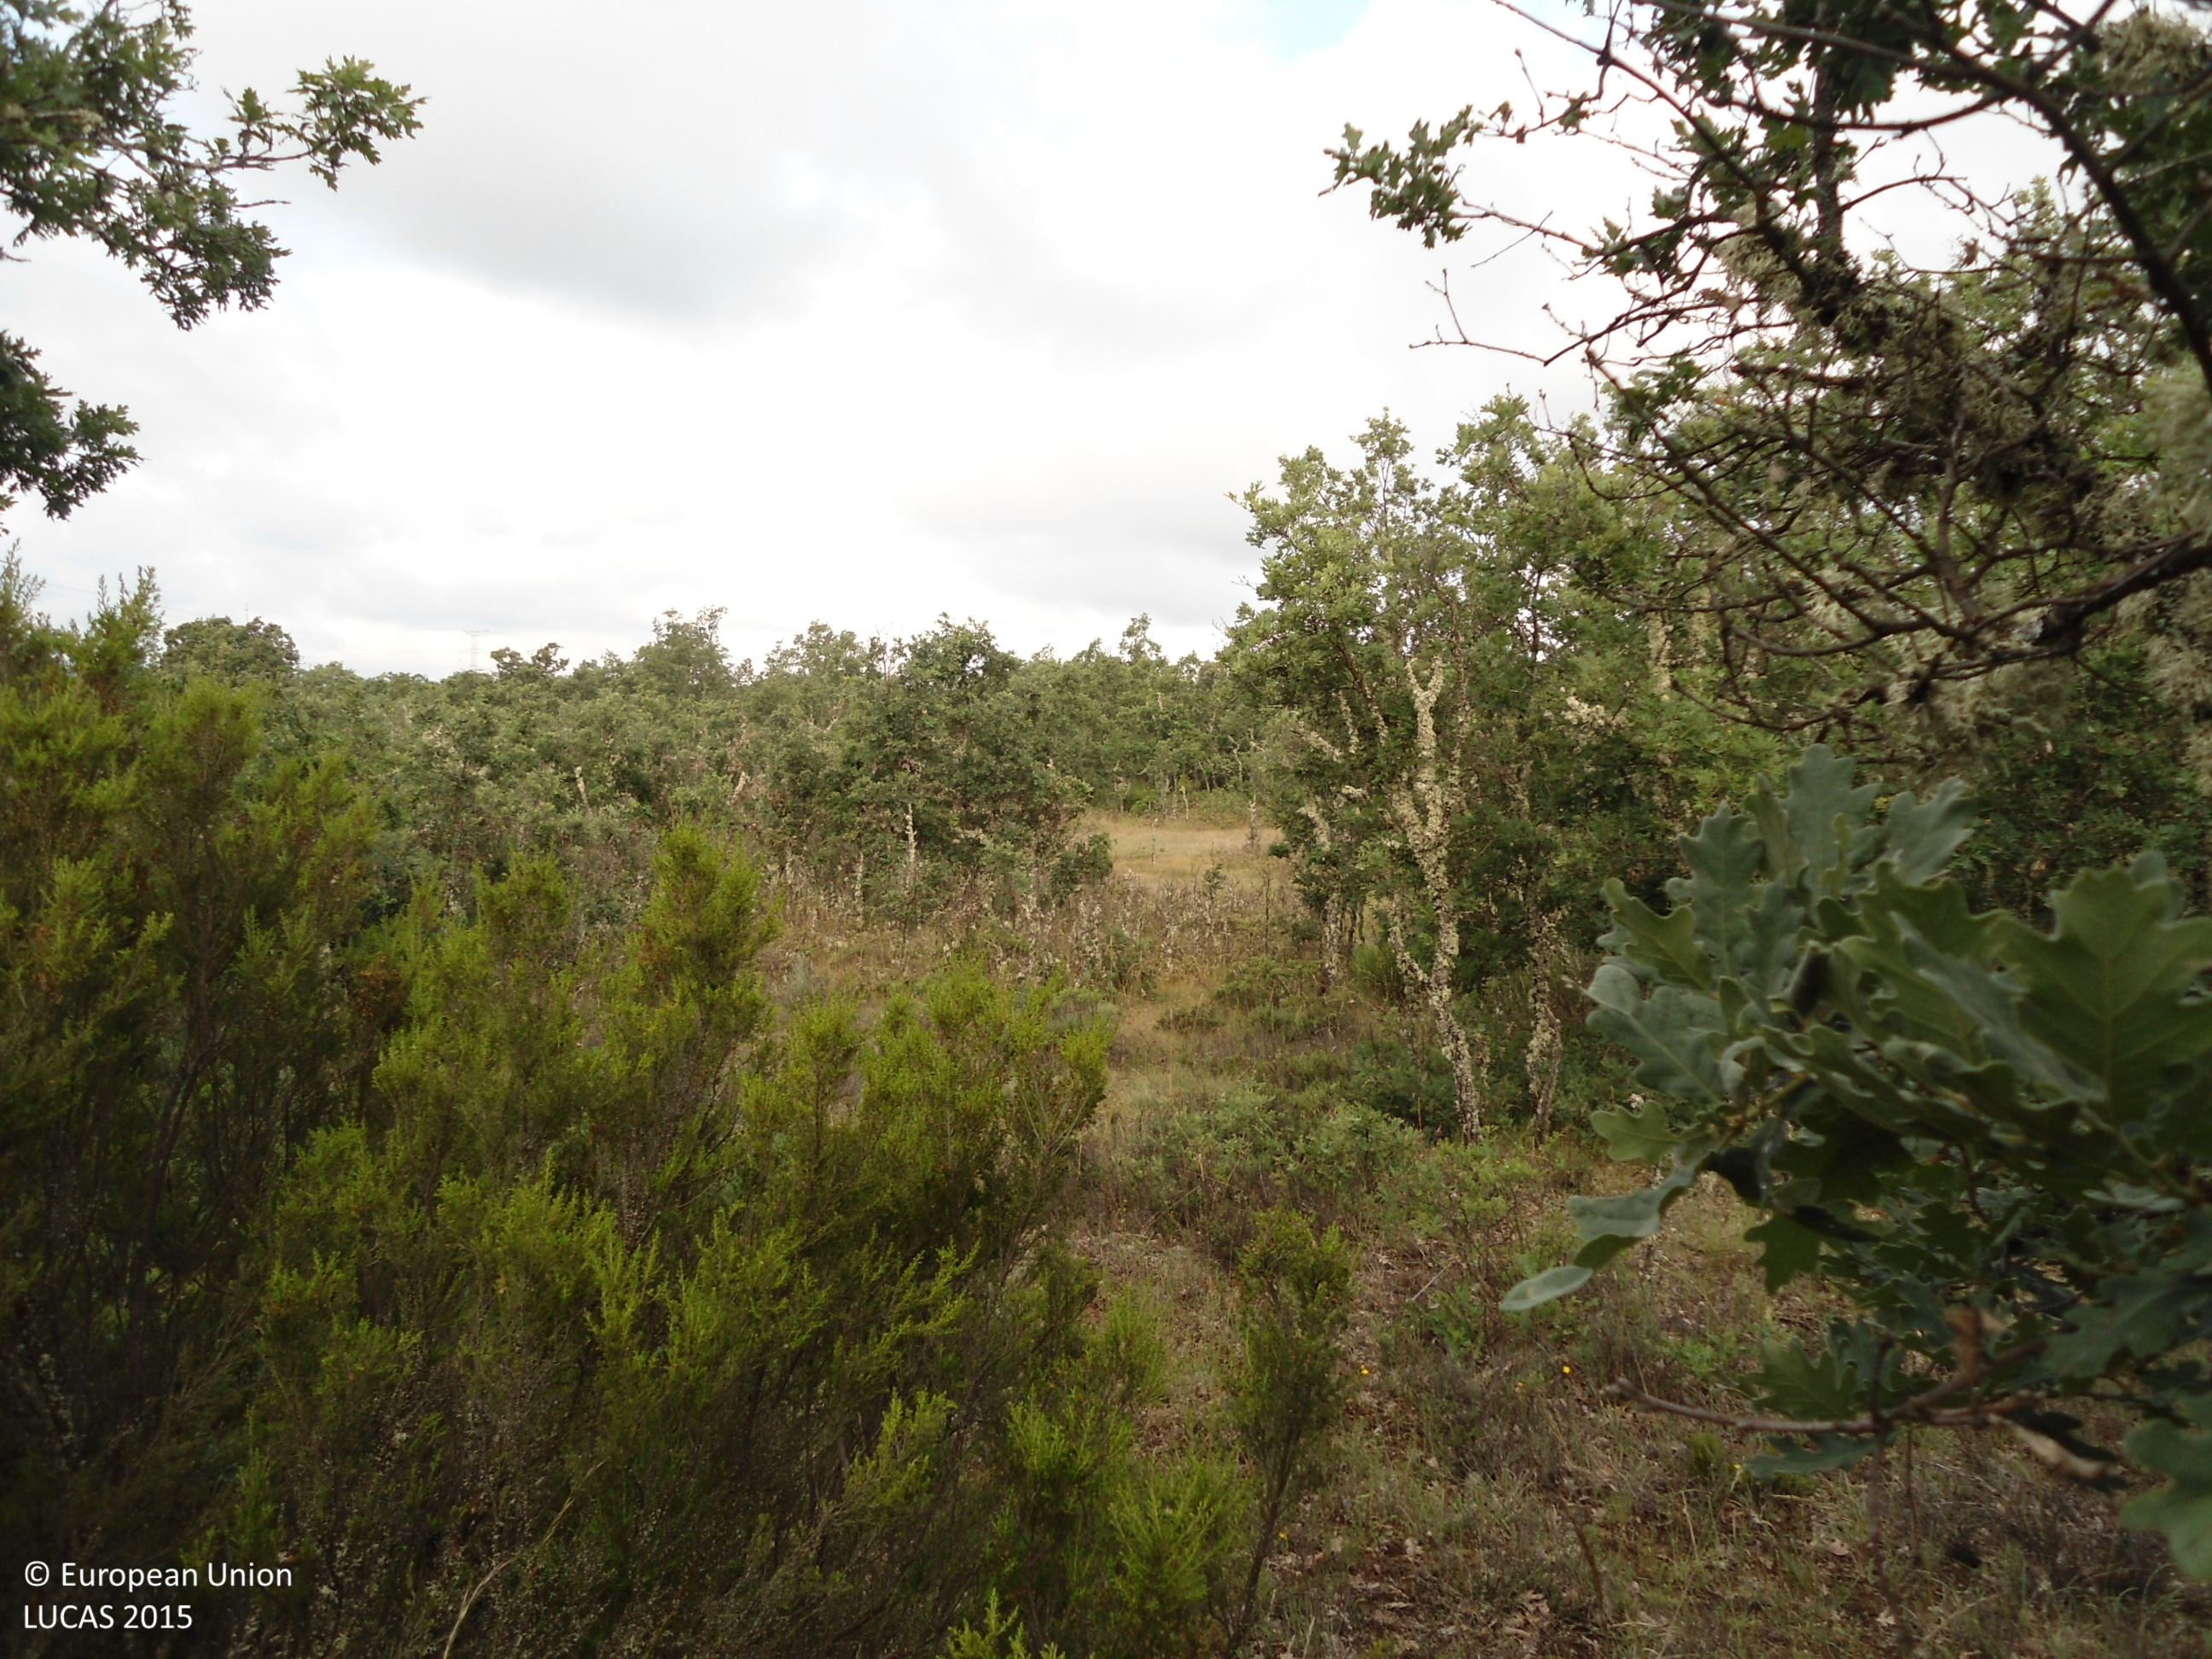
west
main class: Woodland
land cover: Broadleaved woodland
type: broadleaved evergreen forest
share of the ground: > 75 %
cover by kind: broadleaved forest trees 90 %, shrubs 10 %
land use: Forestry
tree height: > 5 m
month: June
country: ES
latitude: 42.0277
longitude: -6.3765
